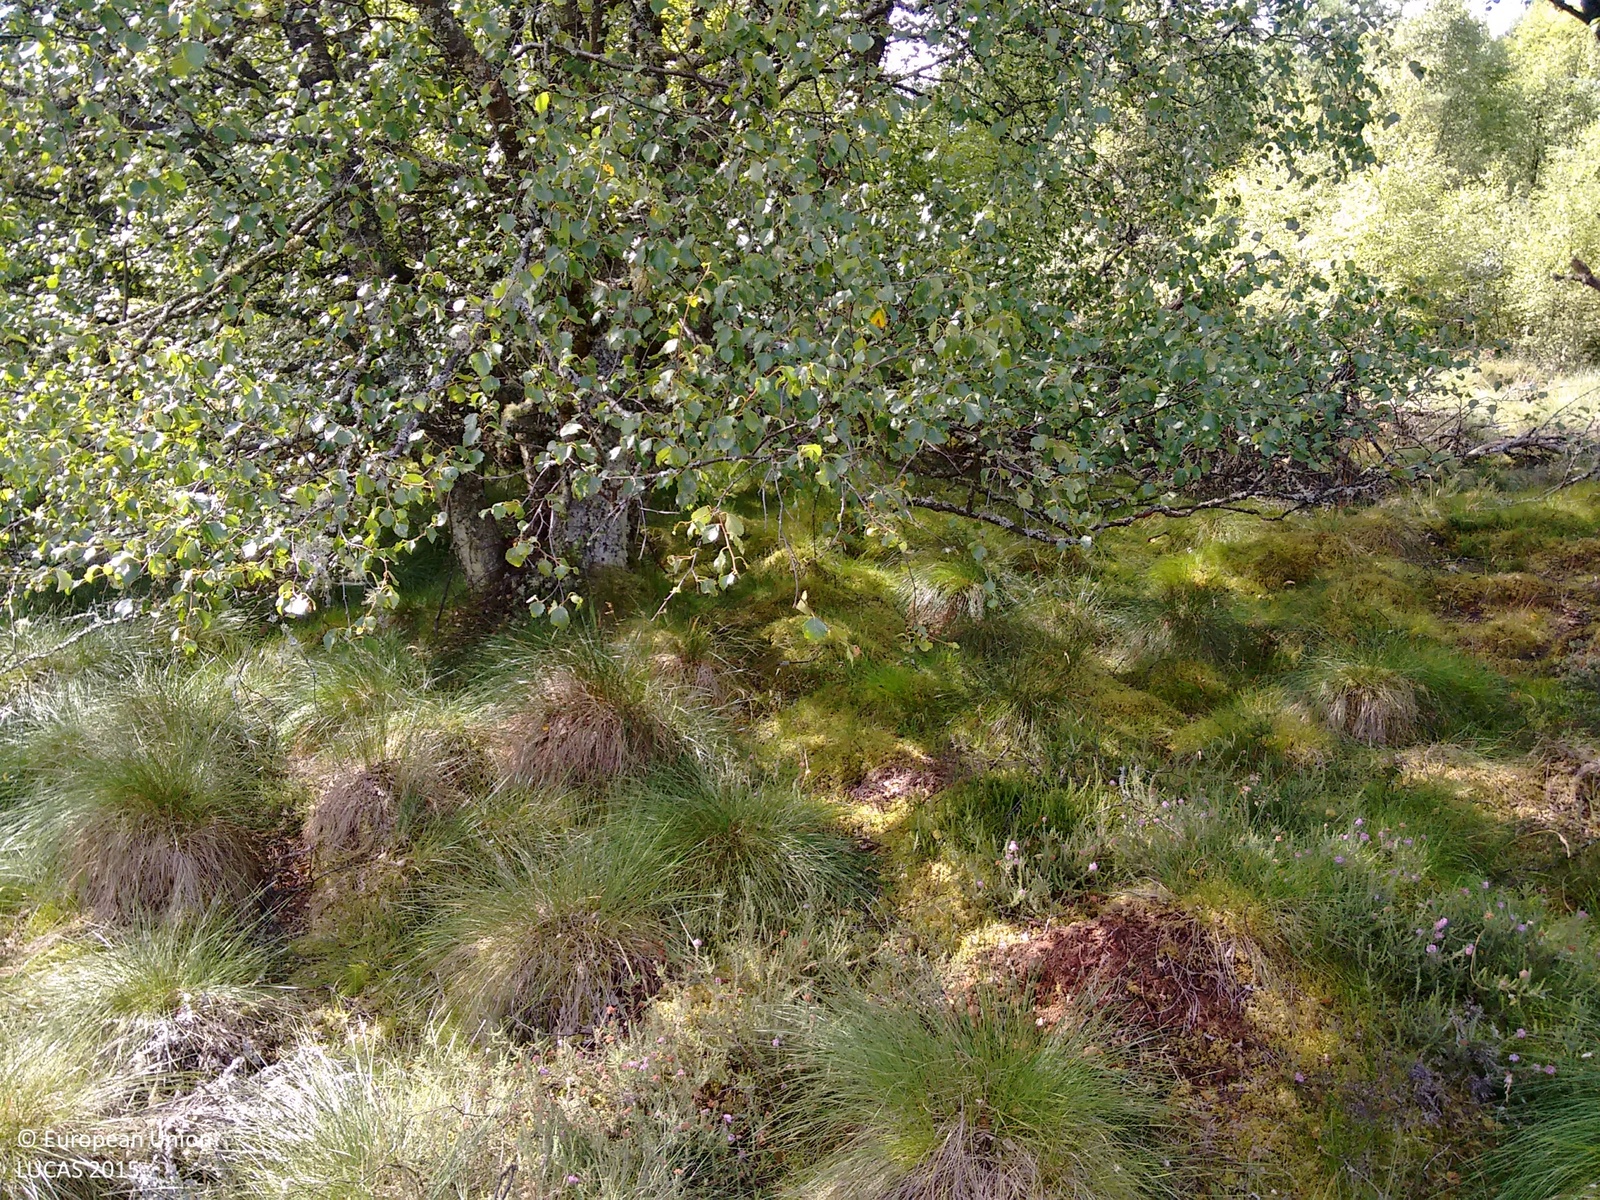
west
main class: Woodland
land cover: Other mixed woodland
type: exotic forest
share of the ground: > 75 %
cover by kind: broadleaved forest trees 55 %, coniferous forest trees 20 %, shrubs 10 %, herbaceous plants 10 %, lichens and mosses 5 %
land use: Forestry
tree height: > 5 m
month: August
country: GB
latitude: 57.5614
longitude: -3.0495
